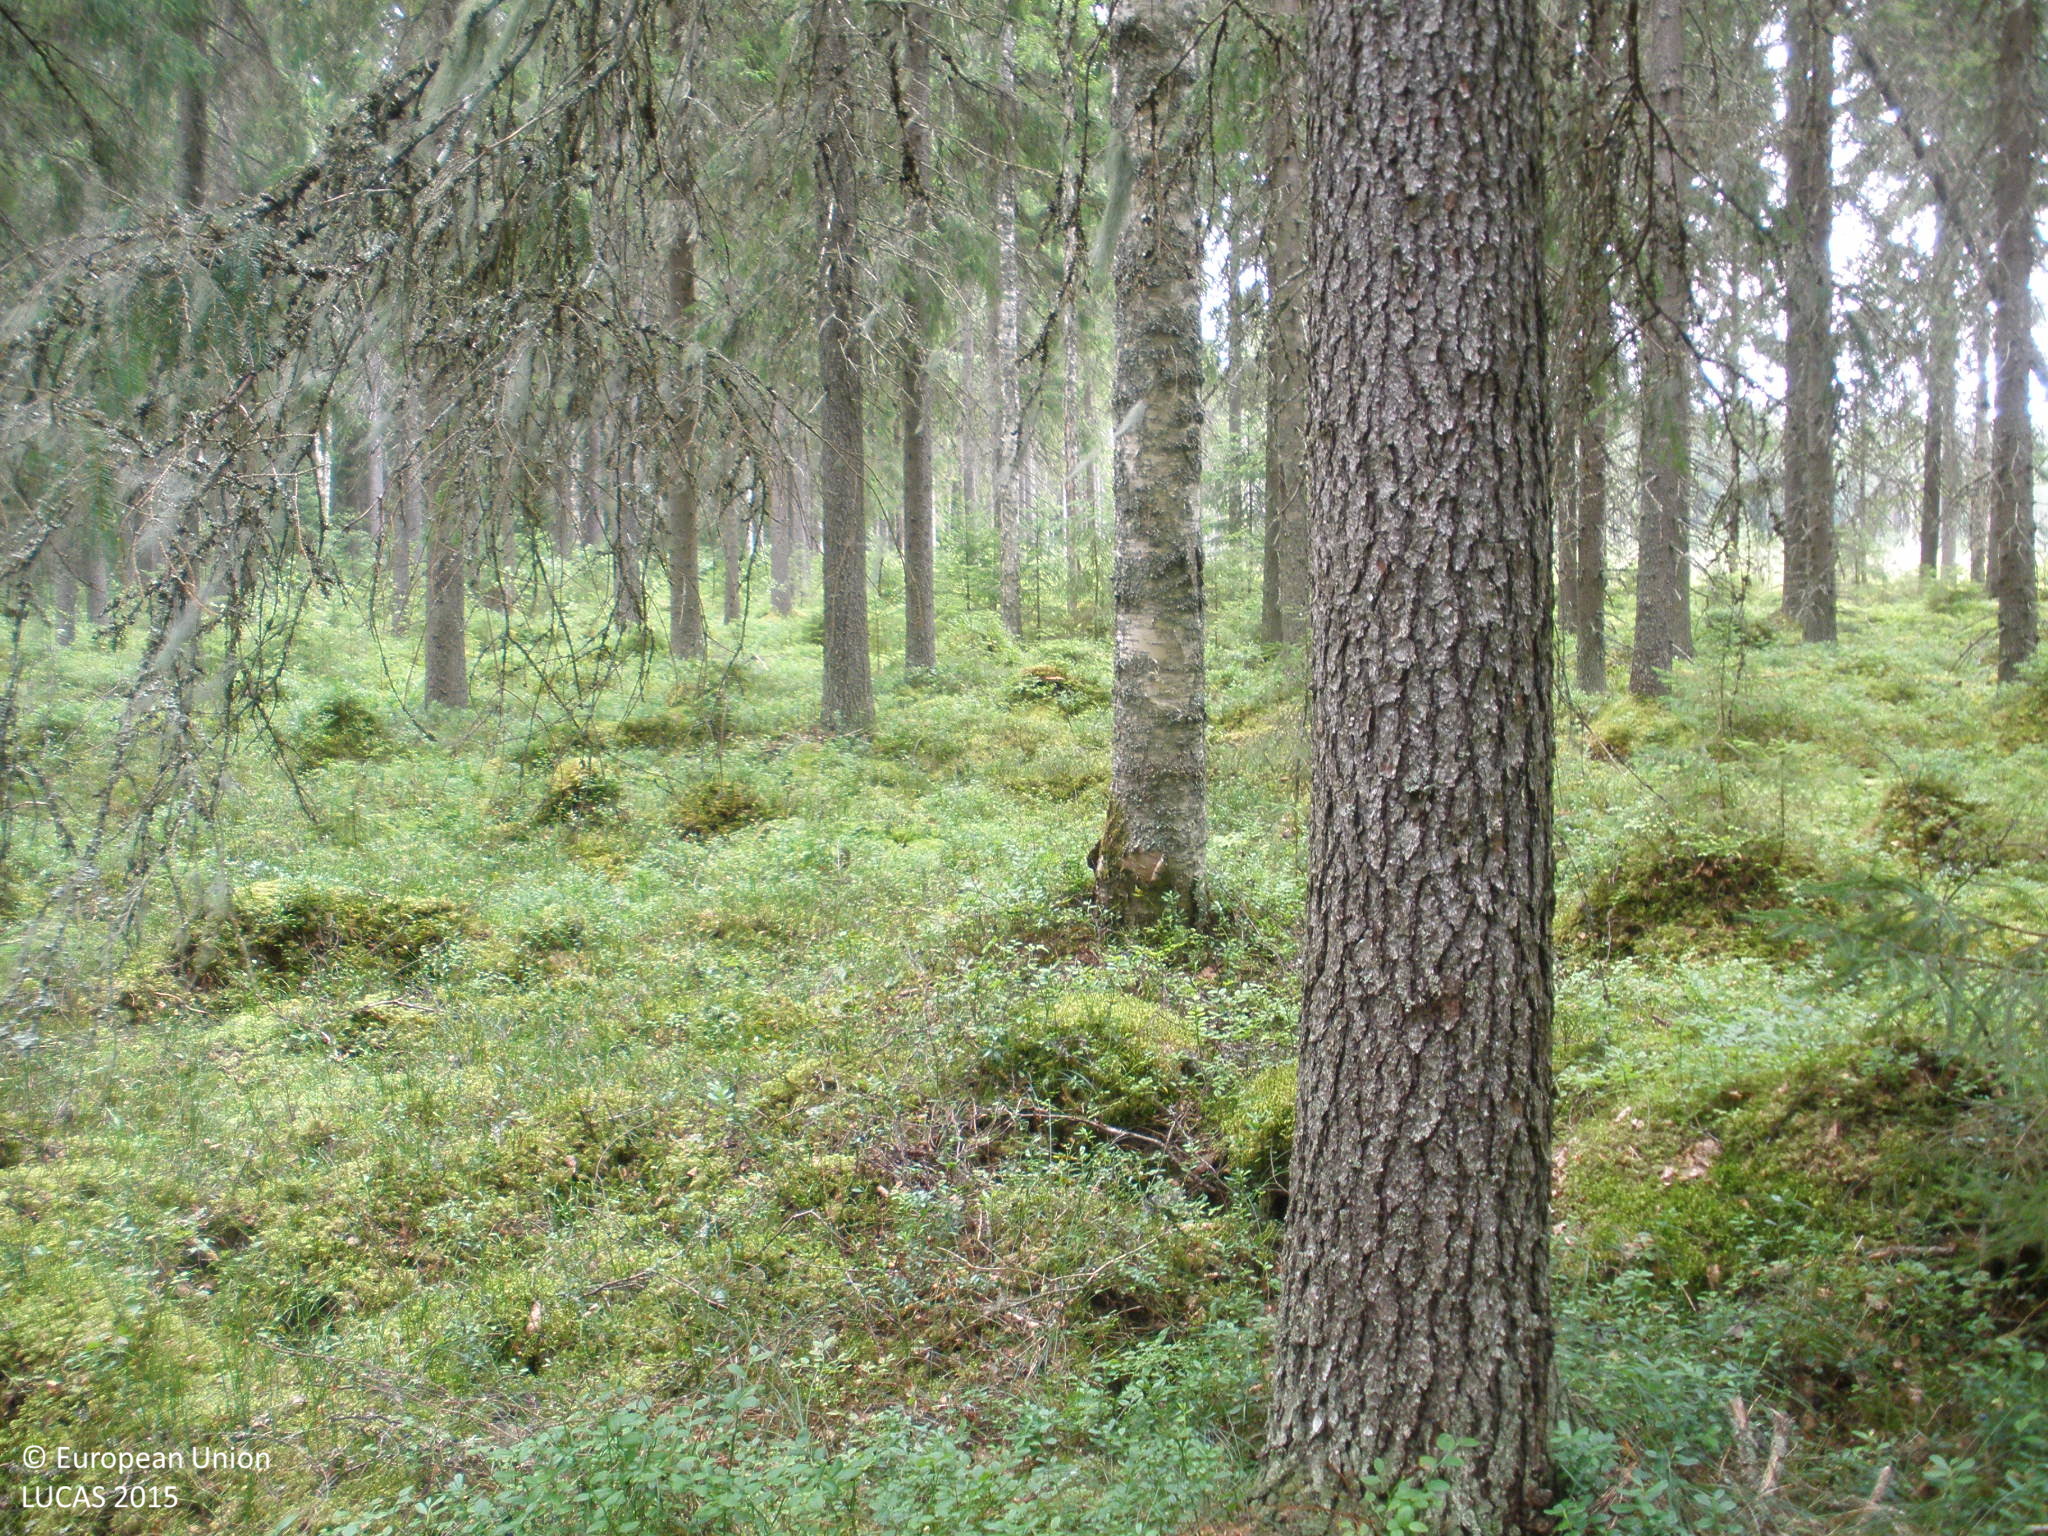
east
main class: Woodland
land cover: Spruce dominated coniferous woodland
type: boreal forest
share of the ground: > 75 %
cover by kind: coniferous forest trees 75 %, shrubs 10 %, lichens and mosses 10 %, herbaceous plants 5 %
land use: Forestry
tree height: > 5 m
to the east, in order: Spruce dominated coniferous woodland; Ditches and canals; Spruce dominated coniferous woodland; Ditches and canals; Spruce dominated mixed woodland; Ditches and canals; Spruce dominated mixed woodland; Rivers and streams; Spruce dominated mixed woodland; Other mixed woodland
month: August
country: FI
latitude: 60.6354
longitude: 23.9704
